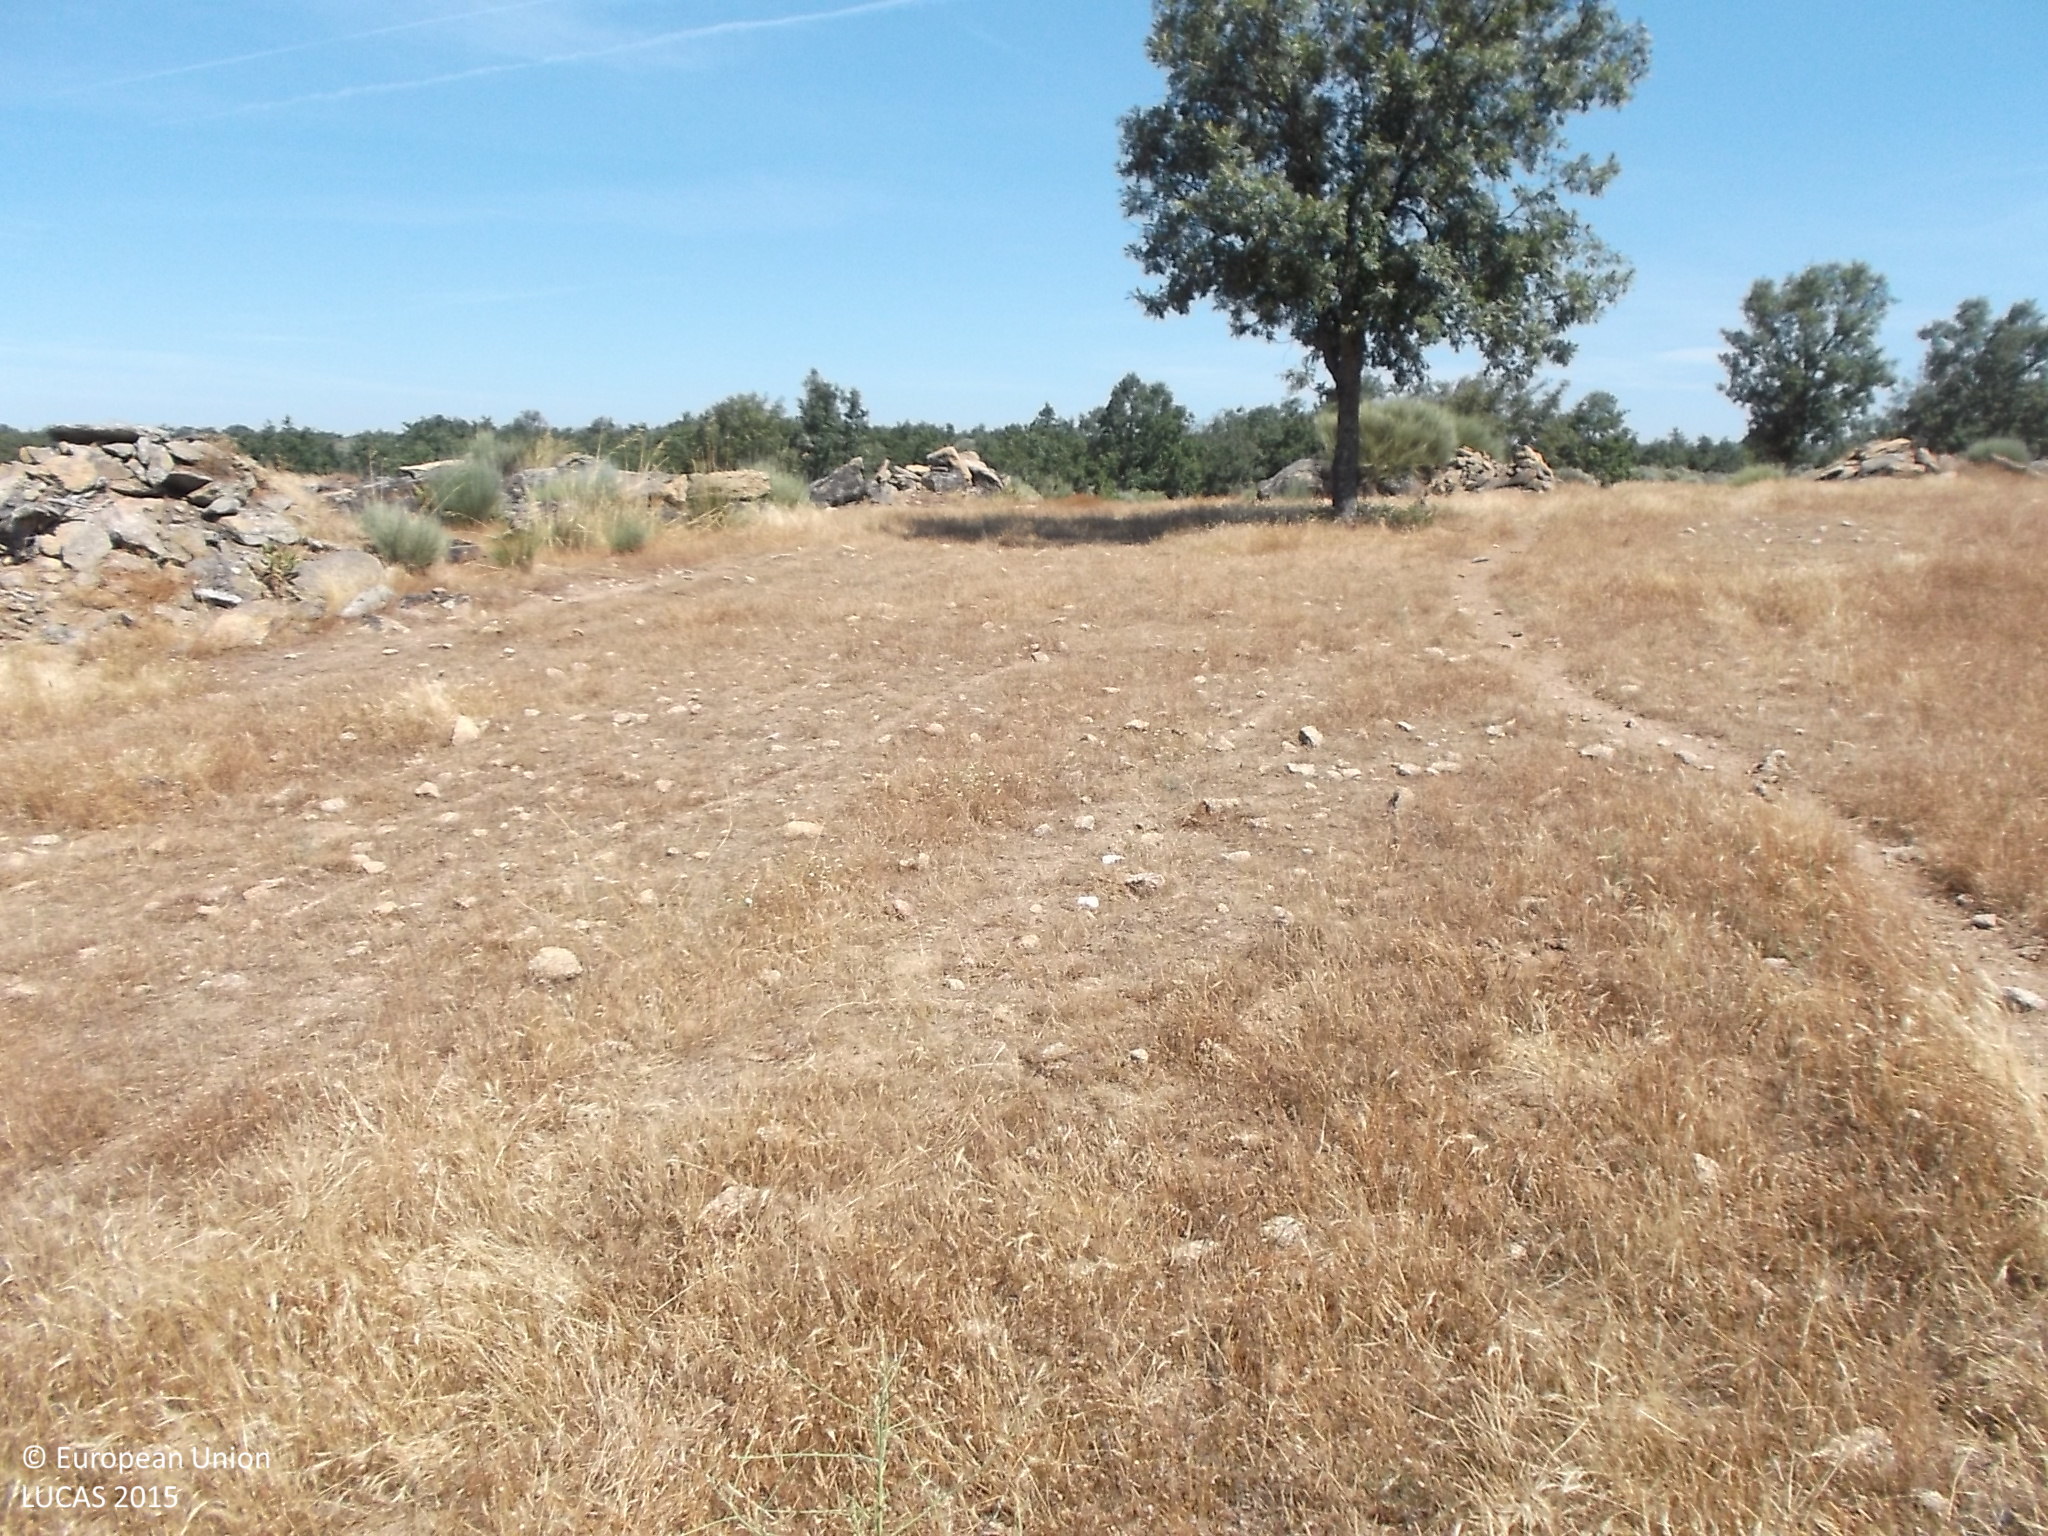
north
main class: Grassland
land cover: Grassland without tree/shrub cover
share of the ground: > 75 %
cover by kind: herbaceous plants 100 %
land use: Agriculture (excluding fallow land and kitchen gardens)
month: July
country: ES
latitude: 41.1851
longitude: -6.4661
